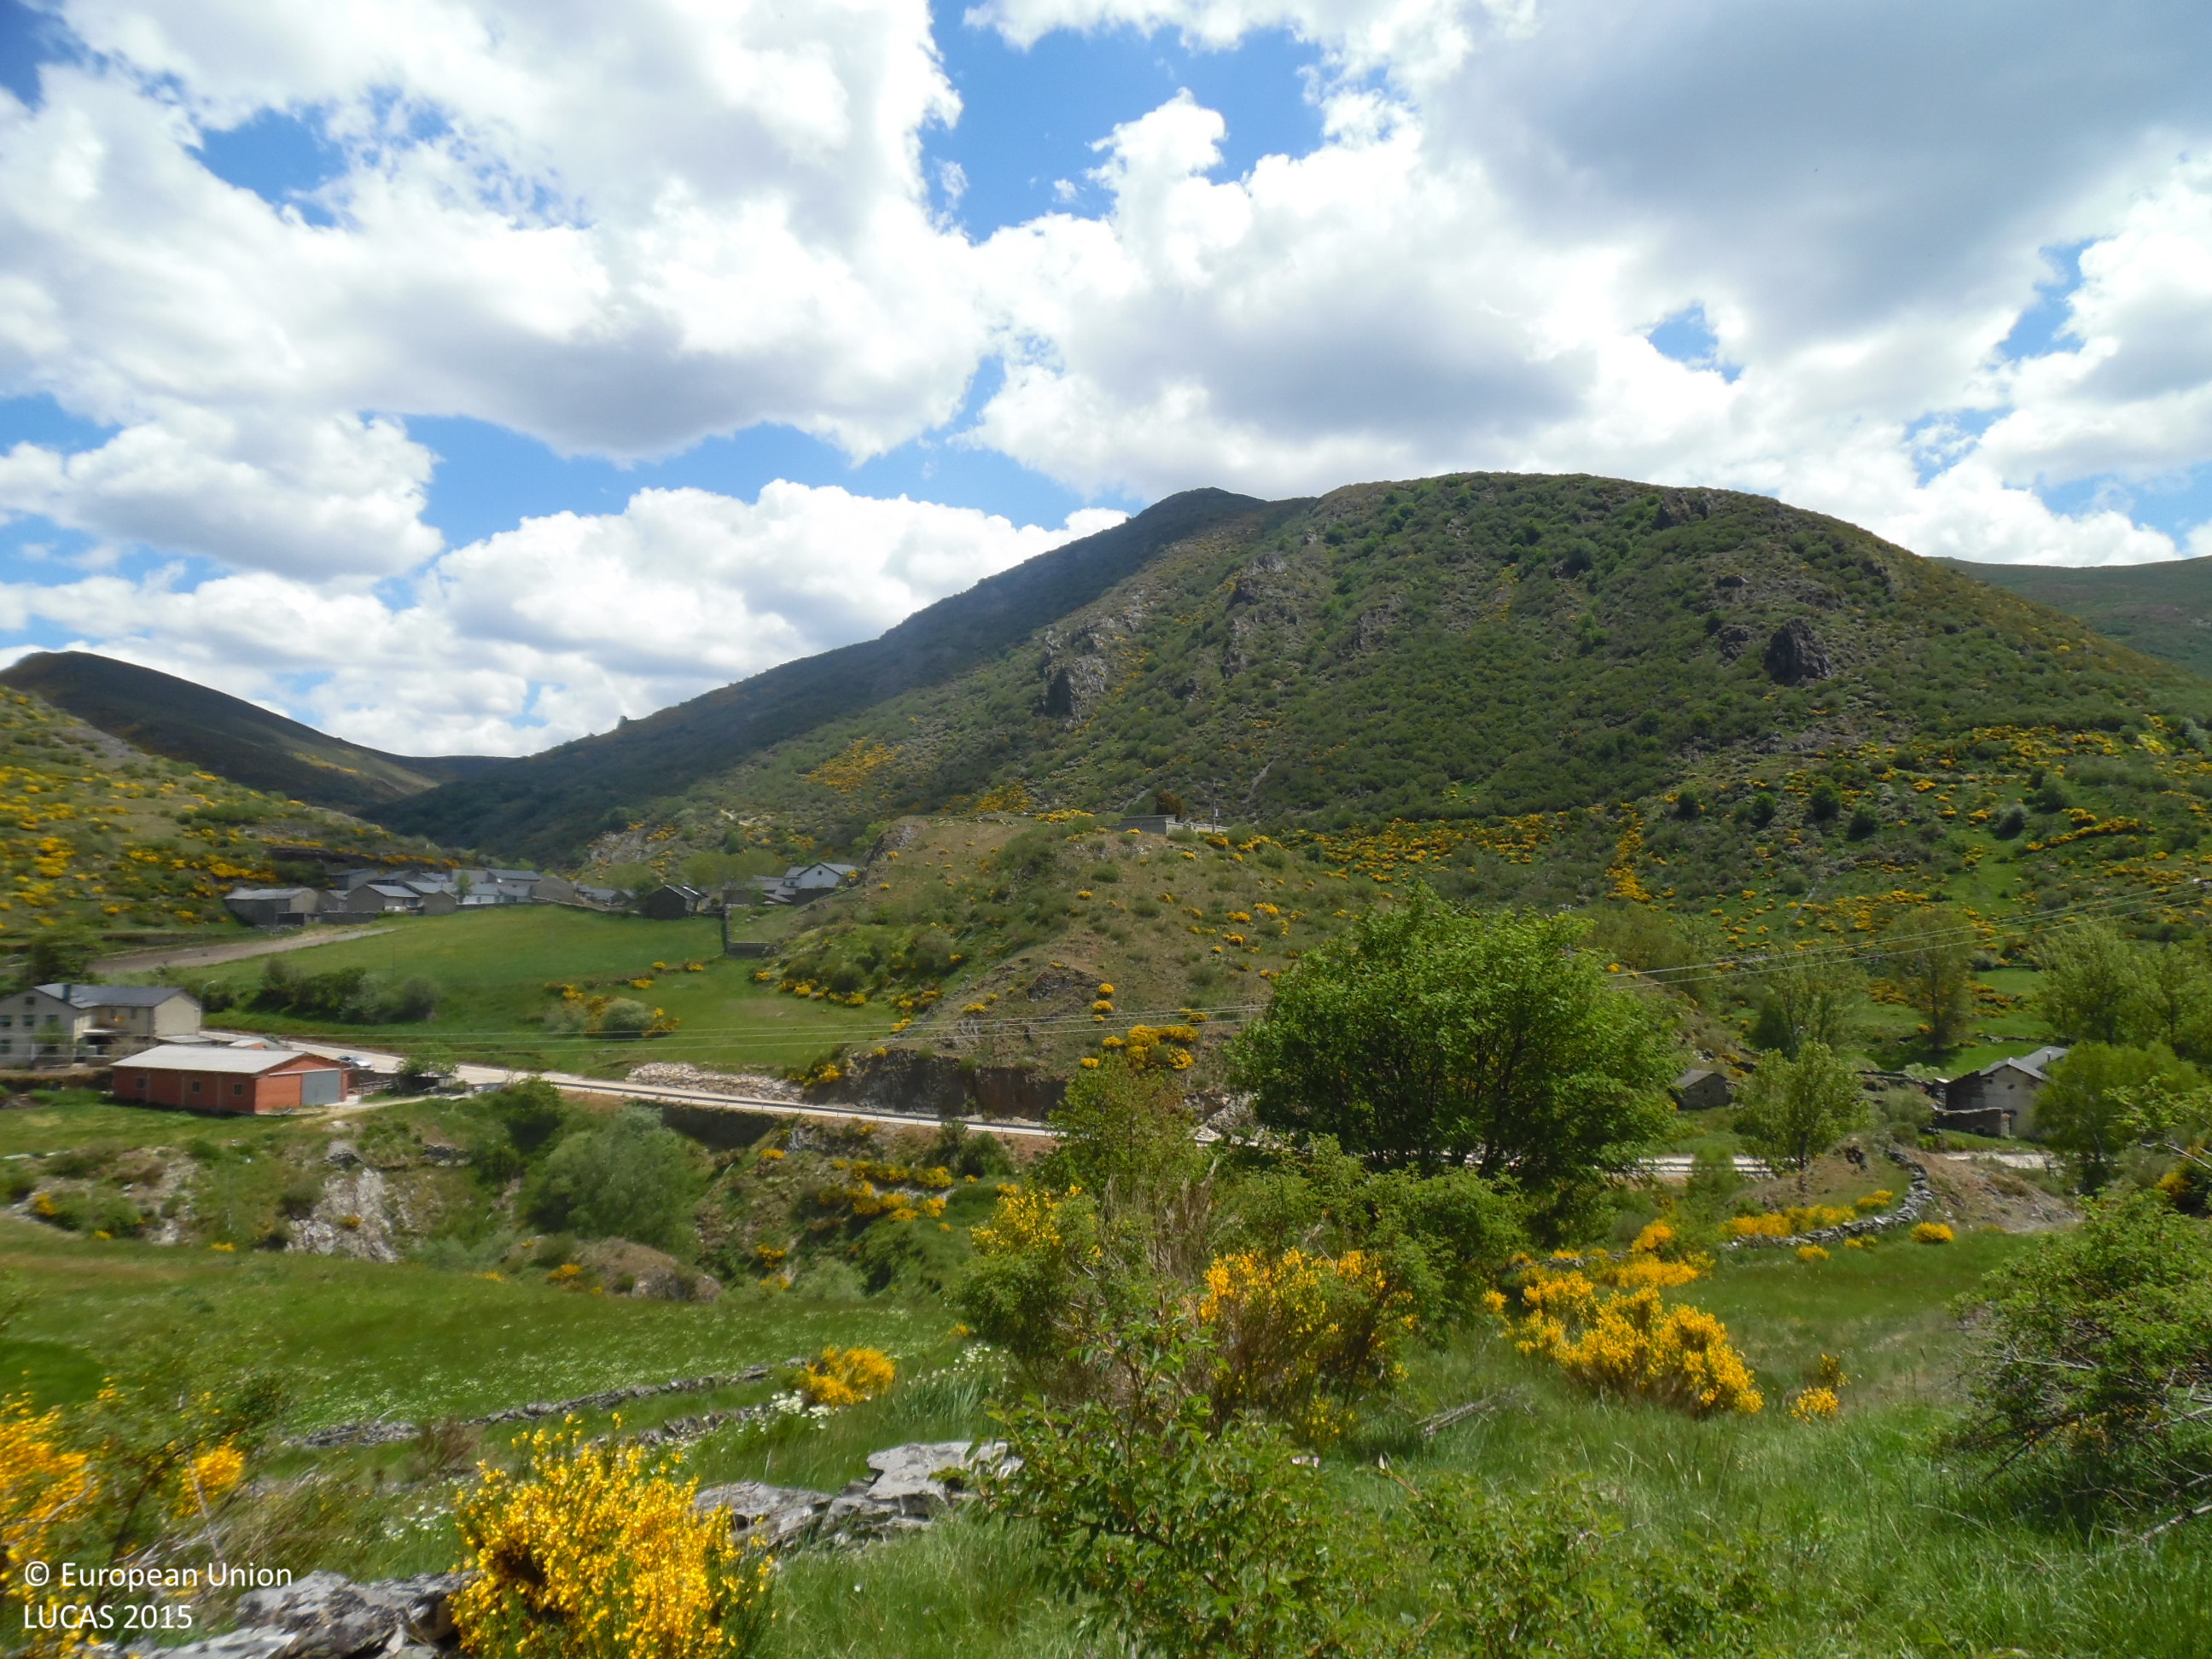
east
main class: Shrubland
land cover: Shrubland with sparse tree cover
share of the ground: > 75 %
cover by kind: shrubs 90 %, broadleaved forest trees 5 %, herbaceous plants 5 %
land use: Agriculture (excluding fallow land and kitchen gardens)
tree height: < 5 m
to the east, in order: Shrubland with sparse tree cover; Shrubland without tree cover; Grassland with sparse tree/shrub cover; Grassland without tree/shrub cover
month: May
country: ES
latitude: 42.8950
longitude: -6.2436
